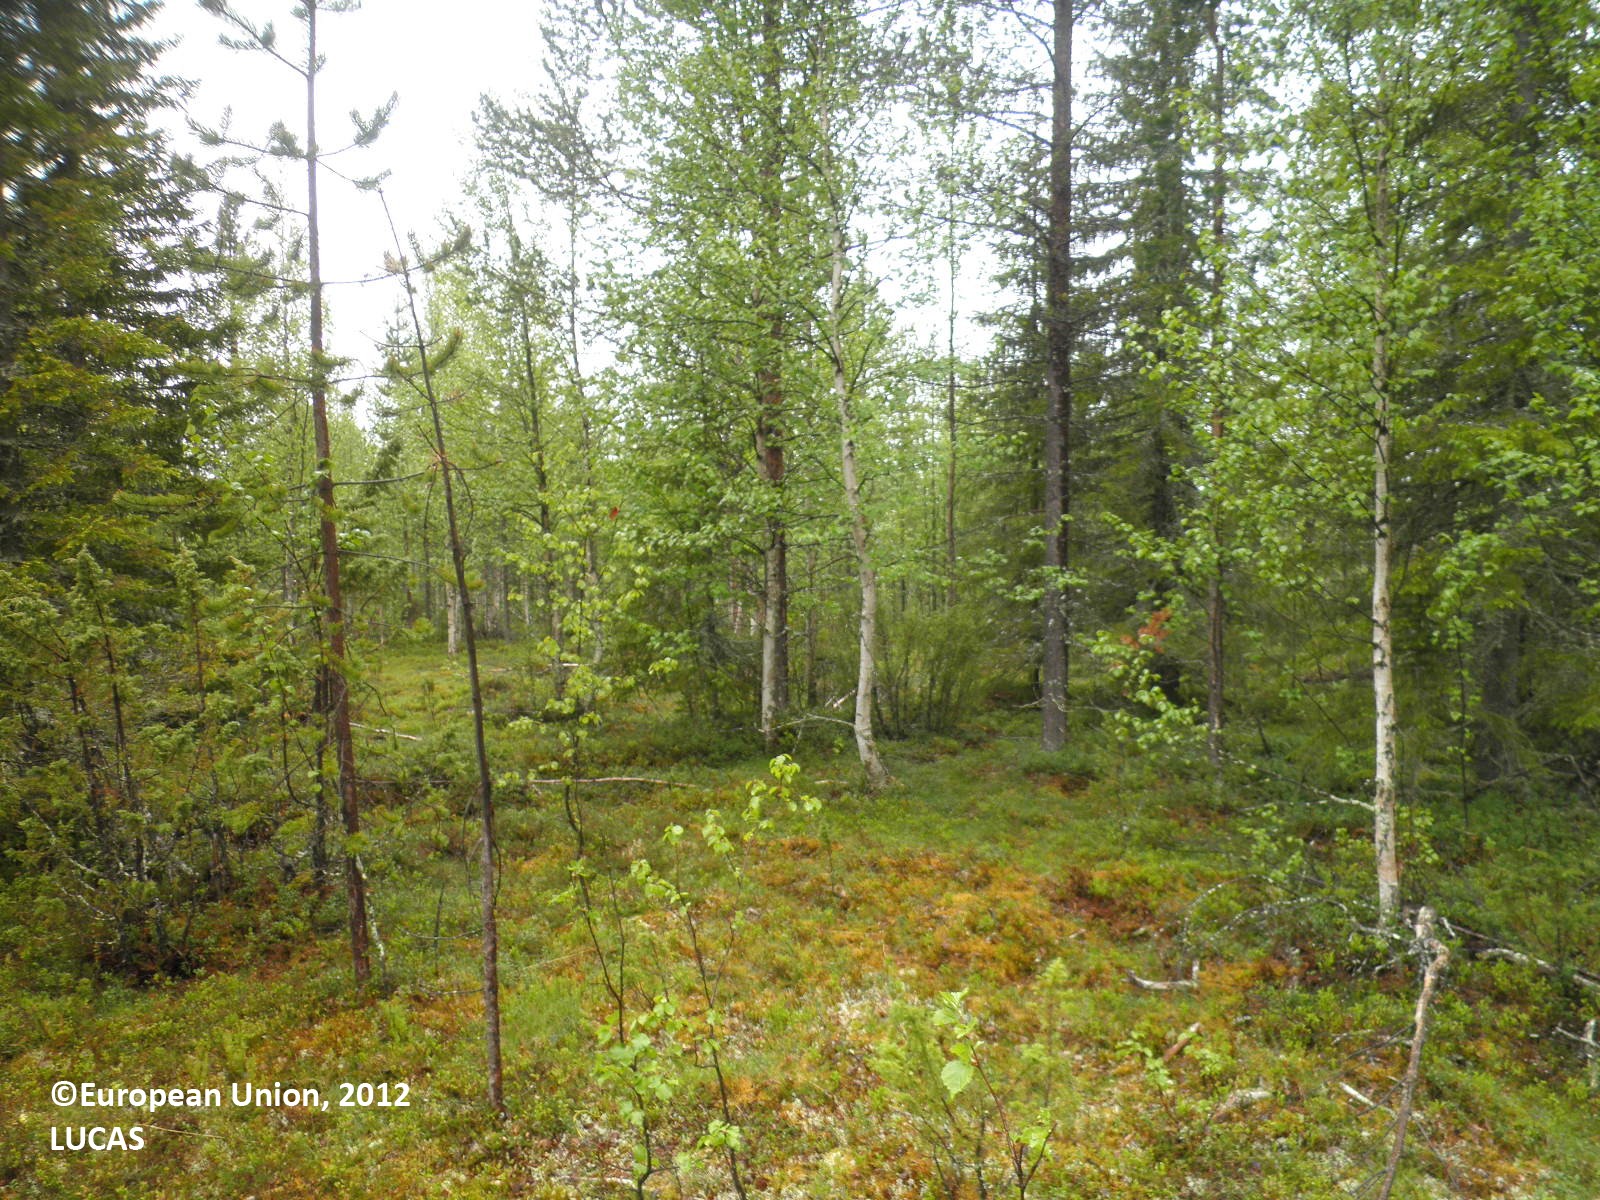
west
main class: Woodland
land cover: Spruce dominated mixed woodland
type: boreal forest
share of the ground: 50 - 75 %
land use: Forestry
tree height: > 5 m
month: June
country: FI
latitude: 67.9718
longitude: 25.6459
